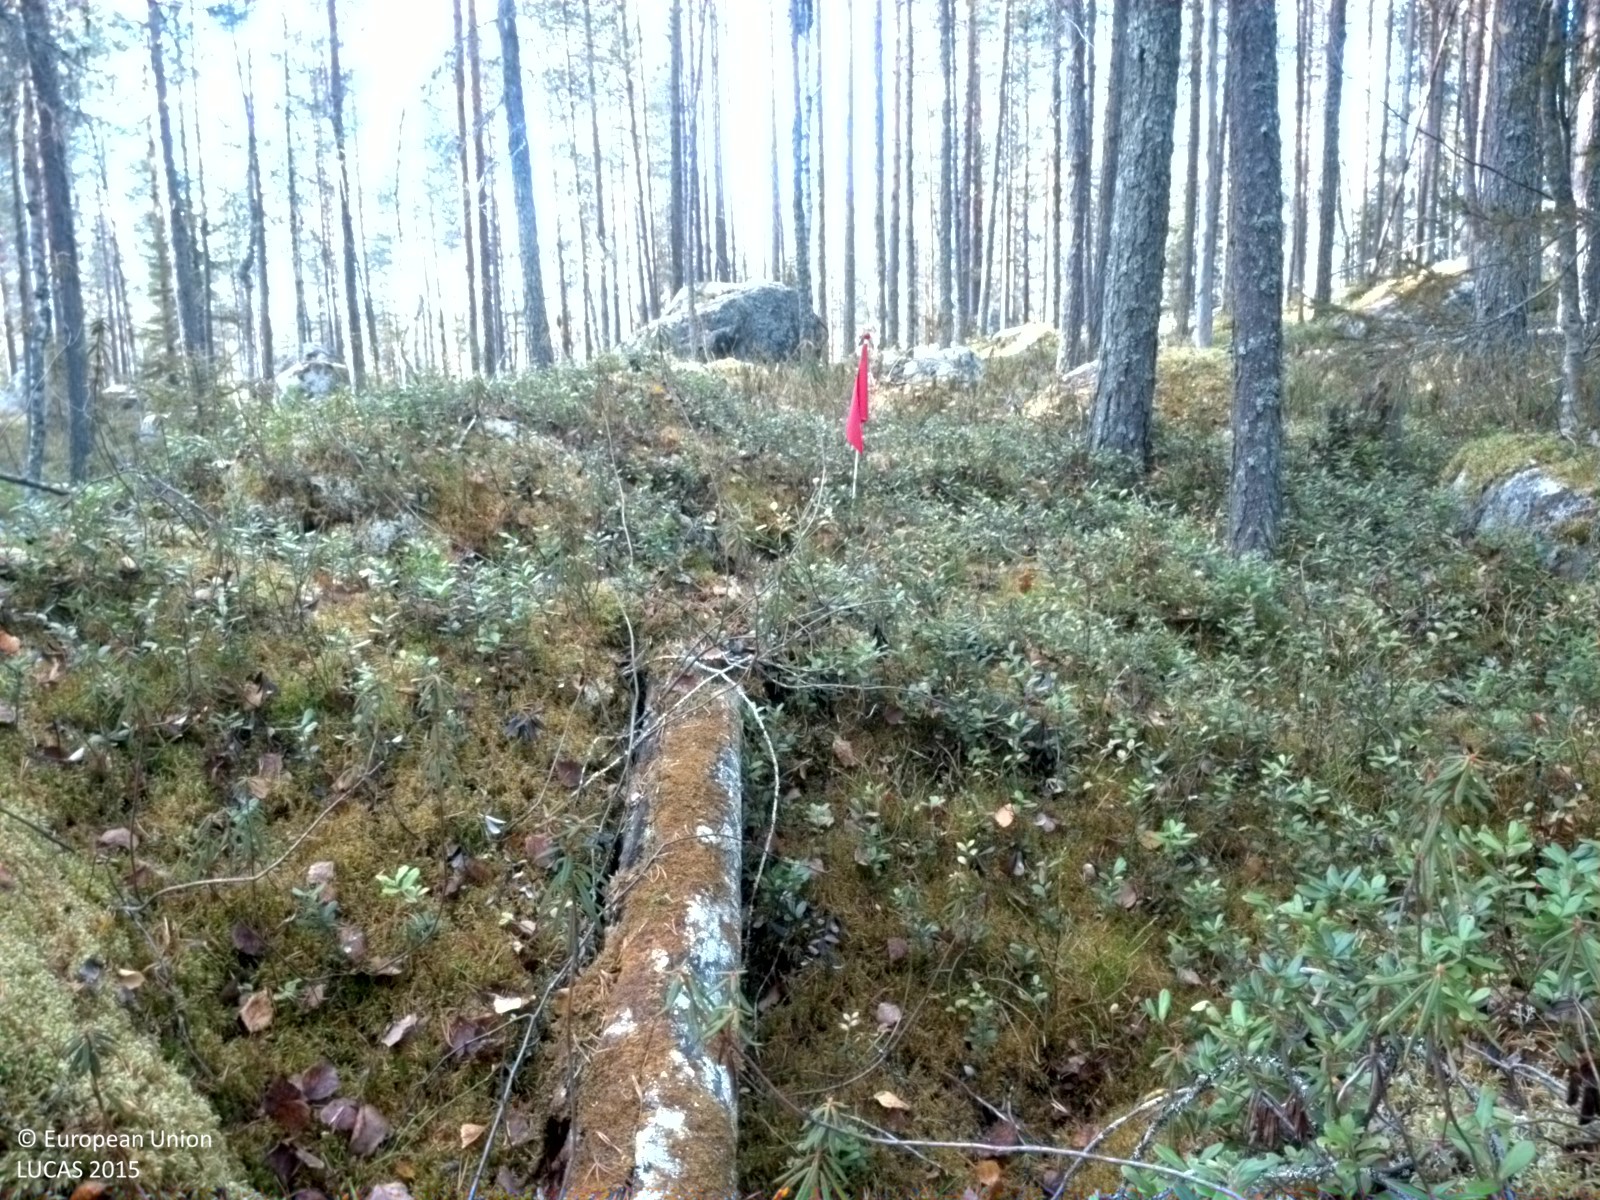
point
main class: Woodland
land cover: Pine dominated coniferous woodland
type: boreal forest
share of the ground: 25 - 50 %
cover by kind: shrubs 60 %, coniferous forest trees 35 %, consolidated bare surface 5 %
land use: Forestry
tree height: > 5 m
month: October
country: SE
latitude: 65.9828
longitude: 22.1509
